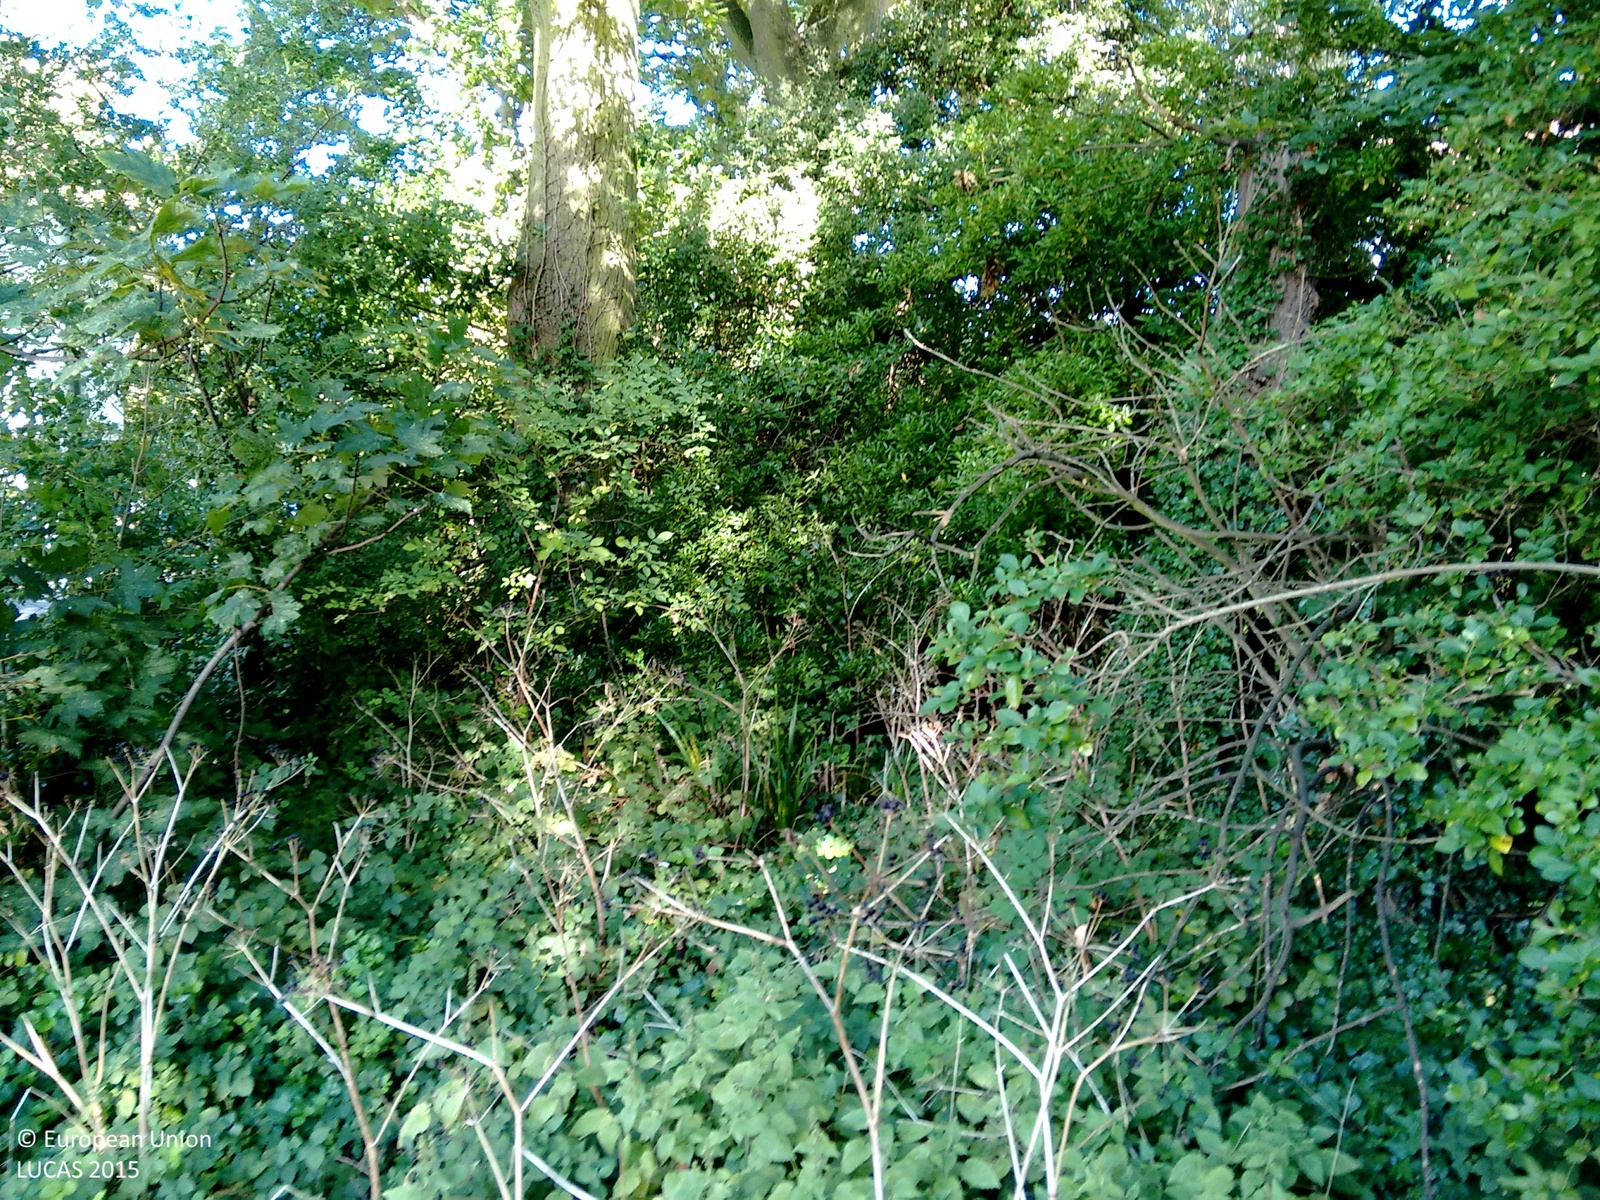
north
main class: Woodland
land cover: Broadleaved woodland
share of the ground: > 75 %
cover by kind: broadleaved forest trees 100 %
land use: Residential
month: September
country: GB
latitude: 52.9262
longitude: 1.3075
